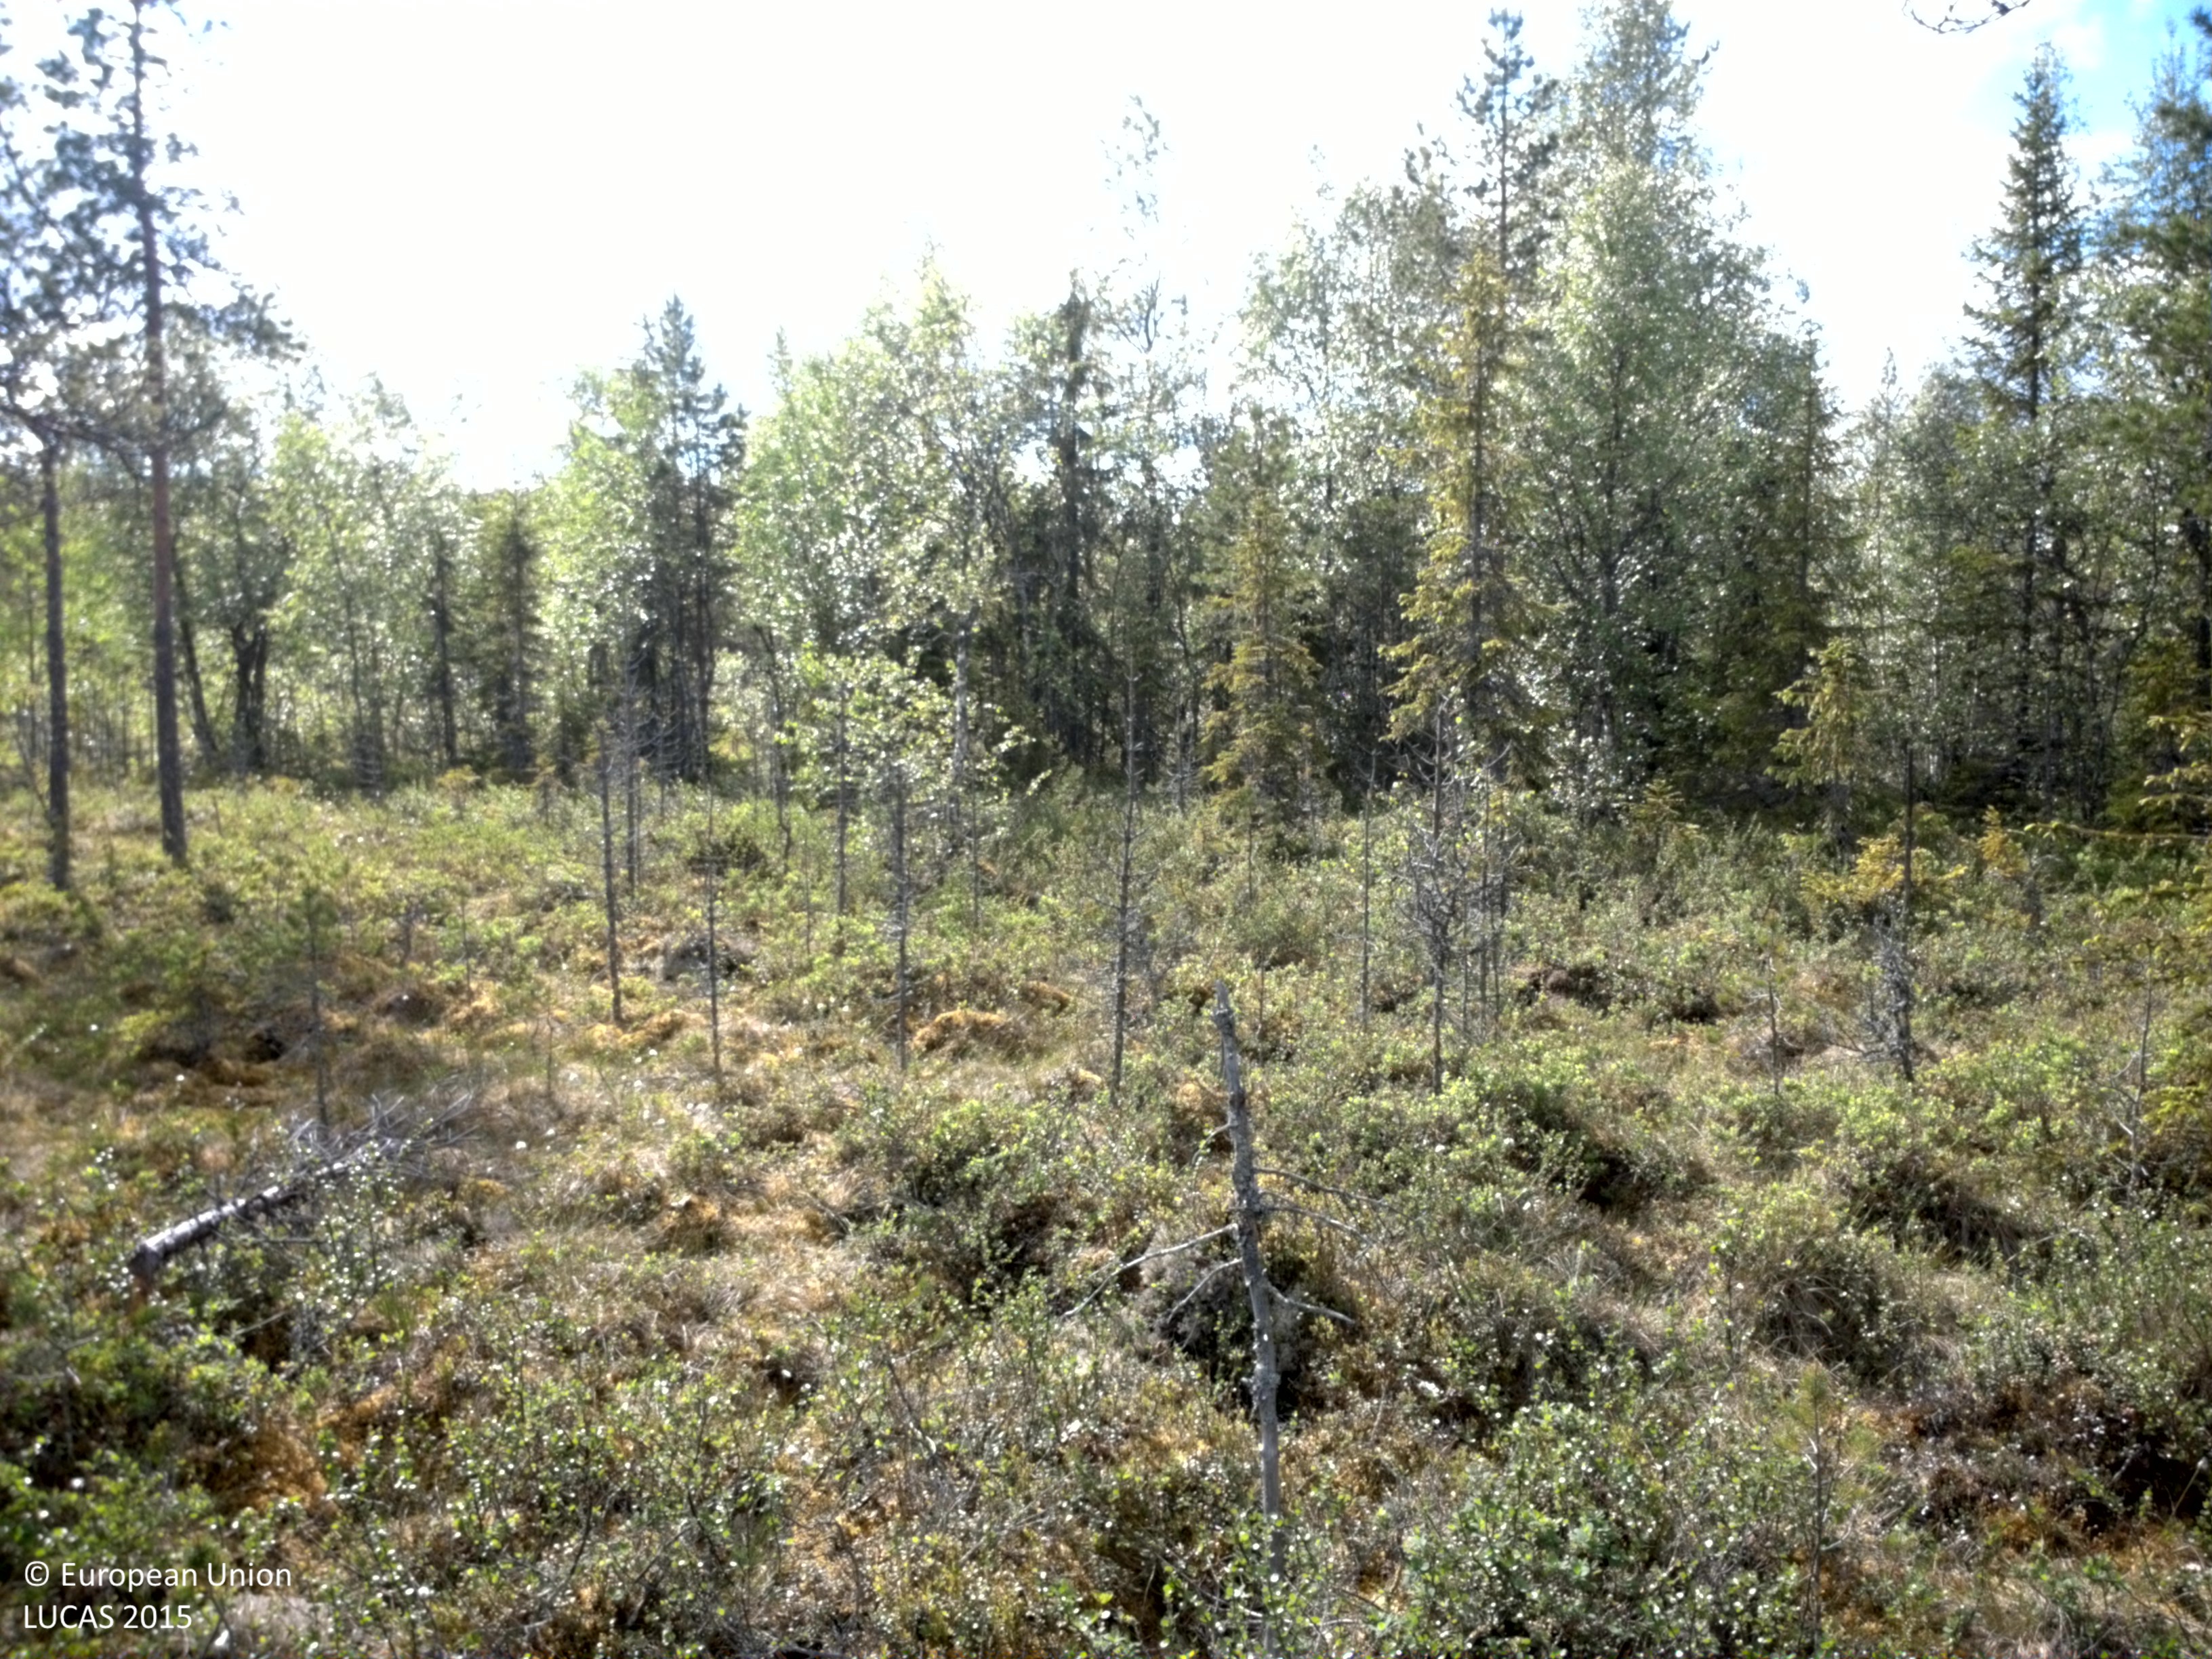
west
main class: Woodland
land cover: Pine dominated coniferous woodland
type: boreal forest
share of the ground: 25 - 50 %
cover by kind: coniferous forest trees 40 %, lichens and mosses 35 %, herbaceous plants 15 %, shrubs 10 %
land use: Semi-natural and natural areas not in use
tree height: > 5 m
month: June
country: SE
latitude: 61.2940
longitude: 13.3663
